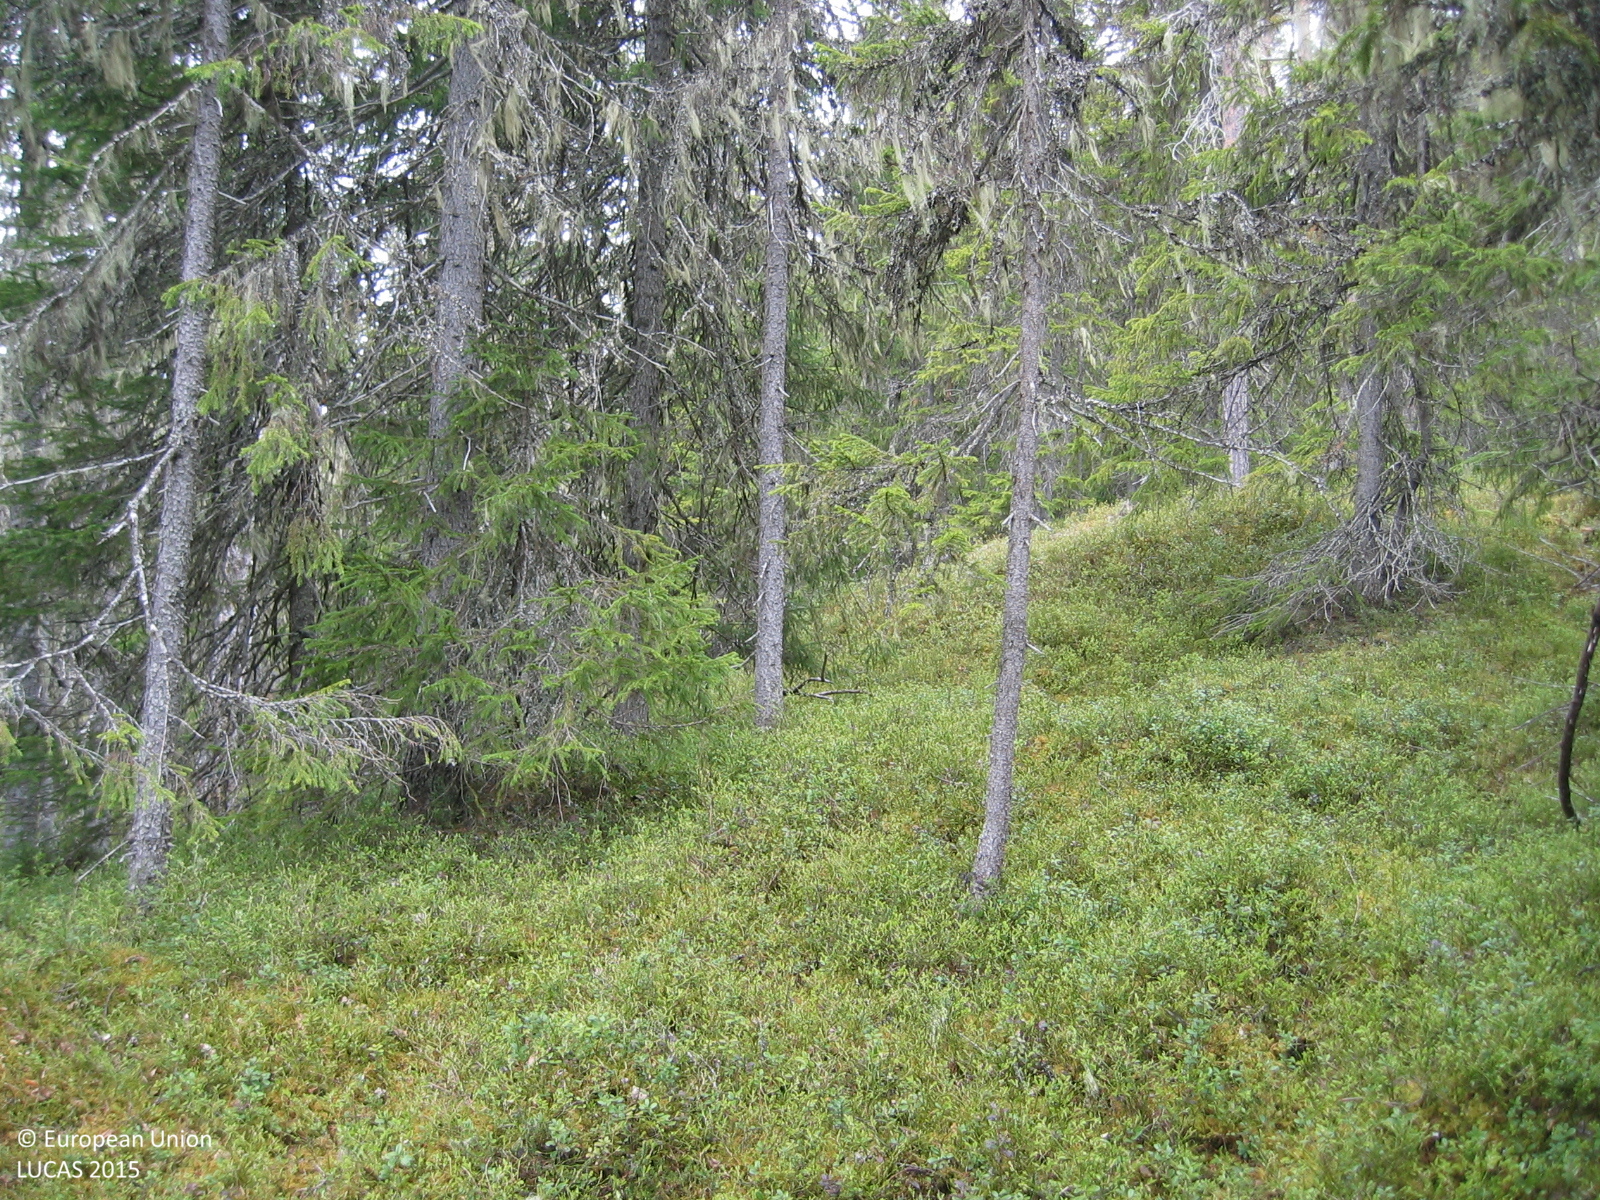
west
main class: Woodland
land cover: Spruce dominated coniferous woodland
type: boreal forest
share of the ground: > 75 %
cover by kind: coniferous forest trees 70 %, shrubs 20 %, broadleaved forest trees 5 %, lichens and mosses 5 %
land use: Forestry
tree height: > 5 m
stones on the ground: 10 - 25 %
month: June
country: SE
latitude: 63.5899
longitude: 13.9493
